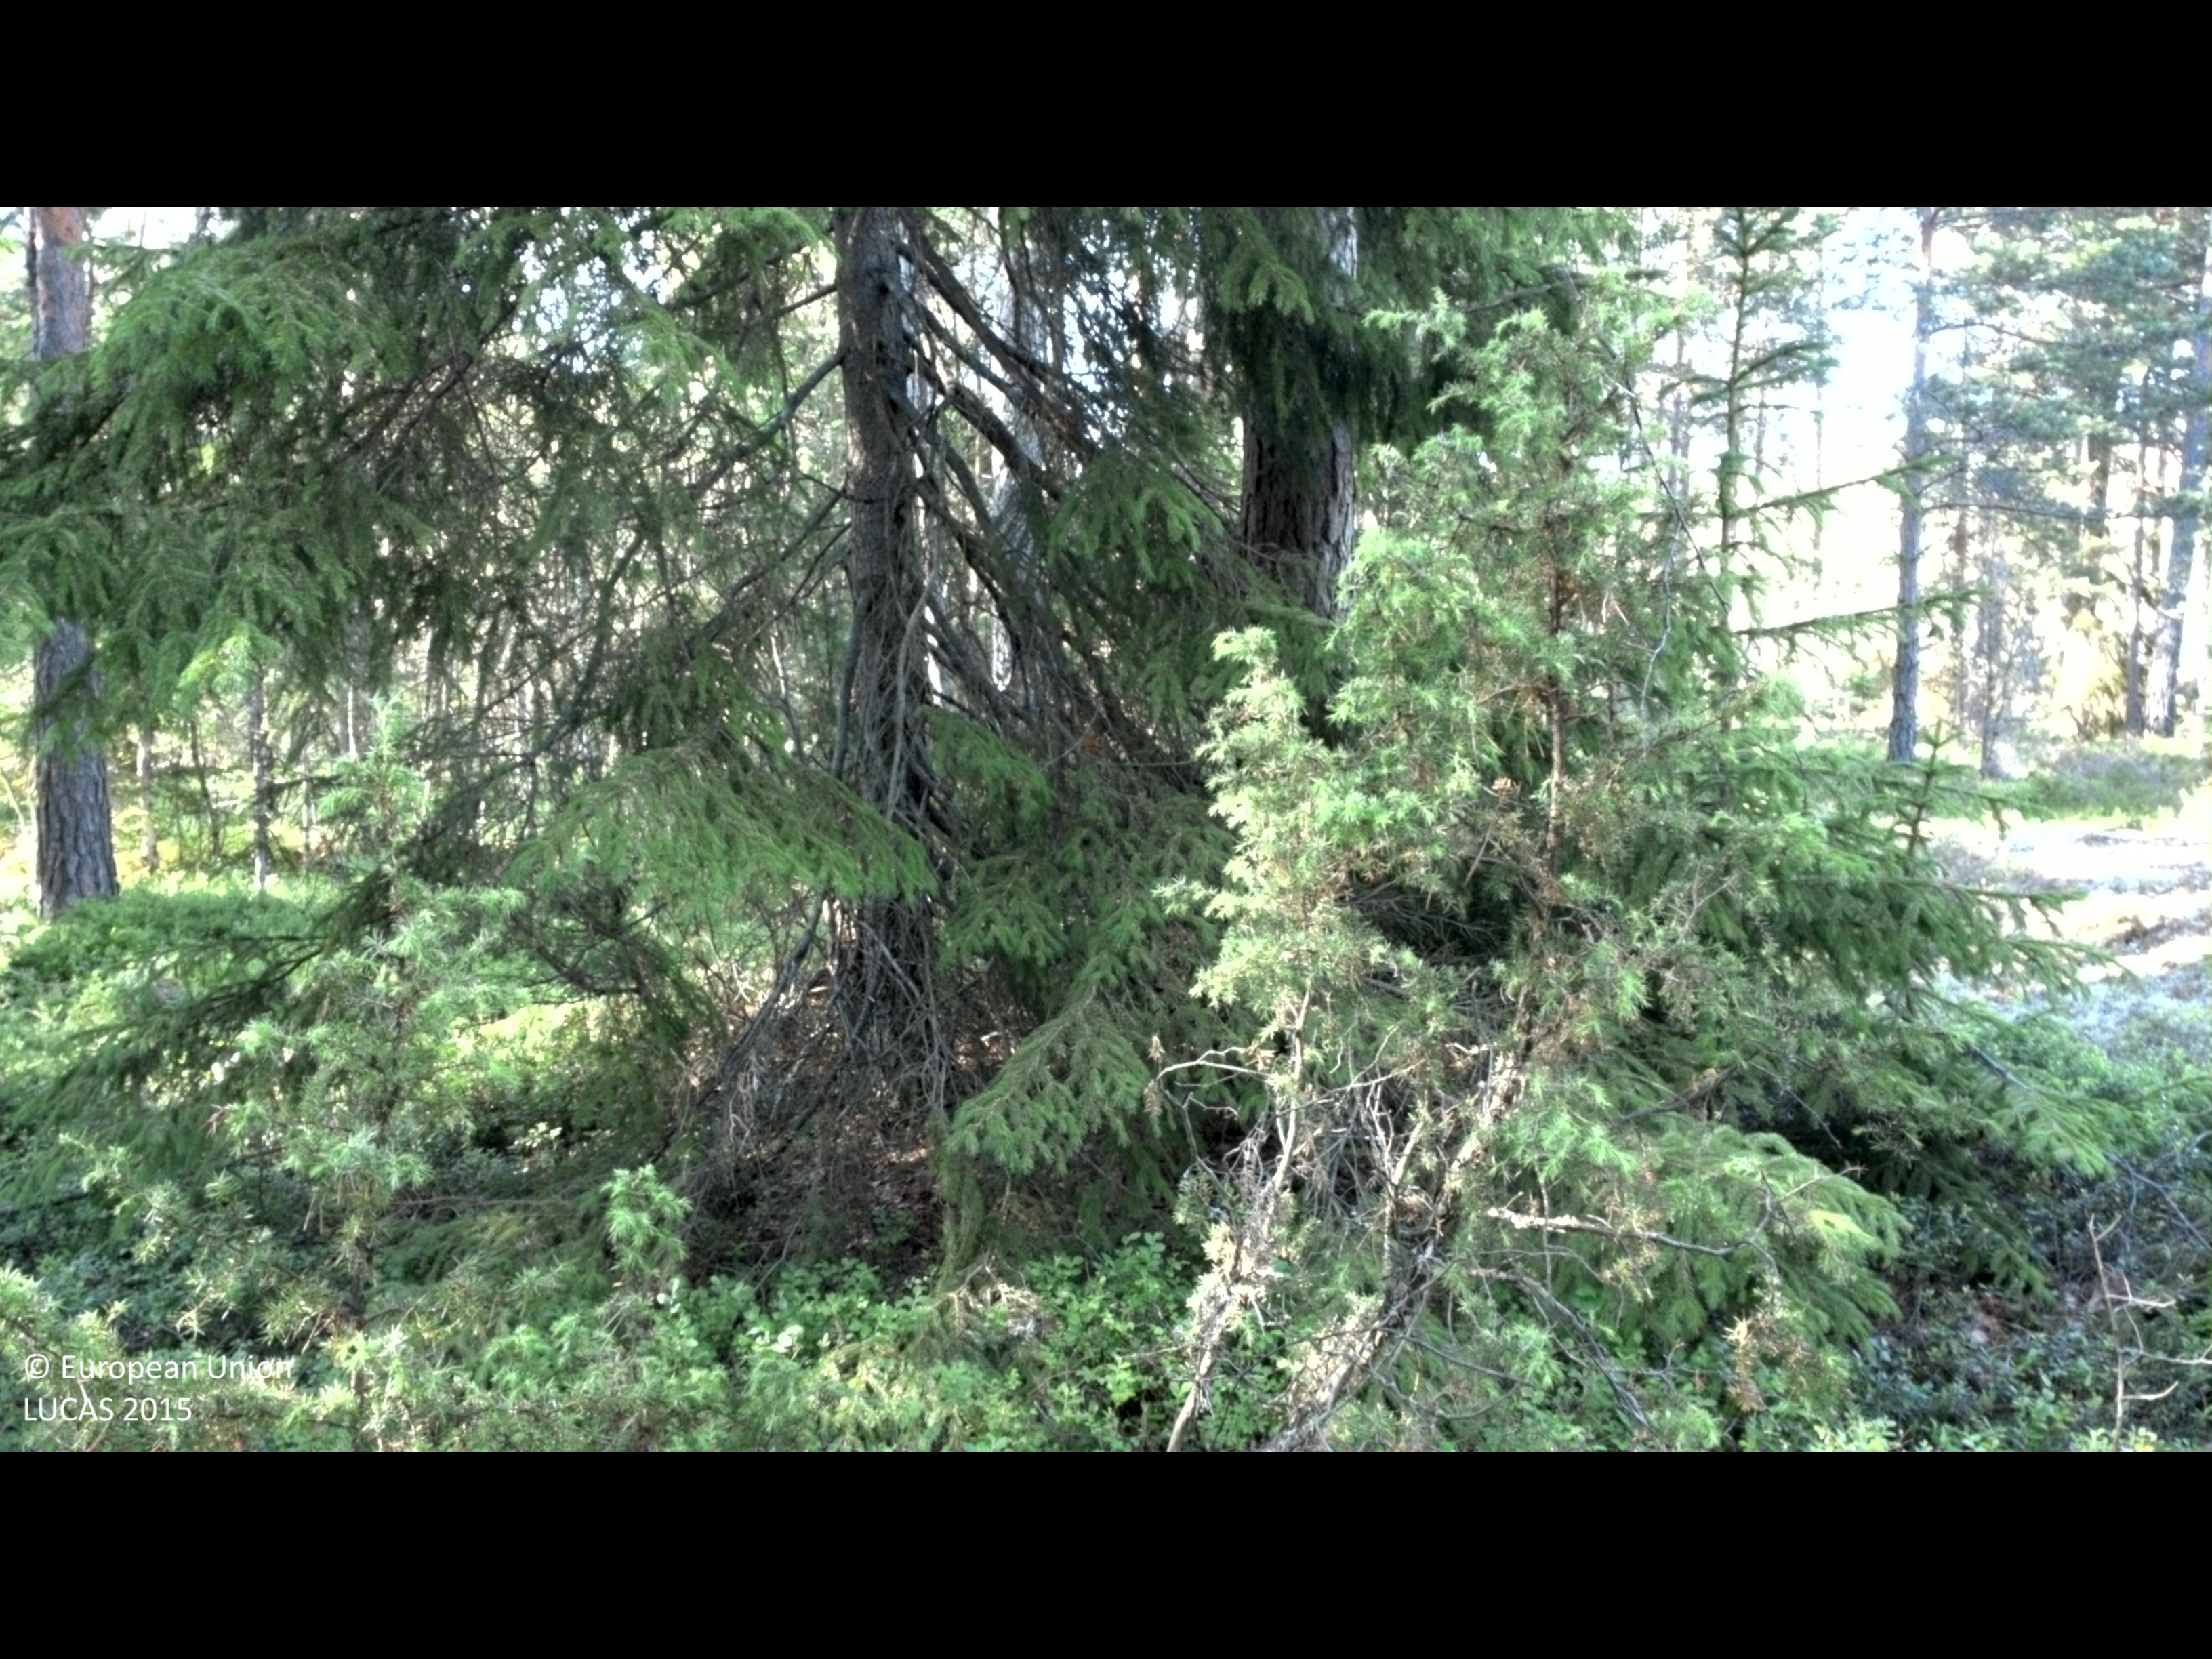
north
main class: Woodland
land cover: Pine dominated coniferous woodland
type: boreal forest
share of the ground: > 75 %
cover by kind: coniferous forest trees 65 %, broadleaved forest trees 15 %, shrubs 15 %, lichens and mosses 5 %
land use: Forestry
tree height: > 5 m
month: June
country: SE
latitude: 58.0171
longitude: 16.6845
